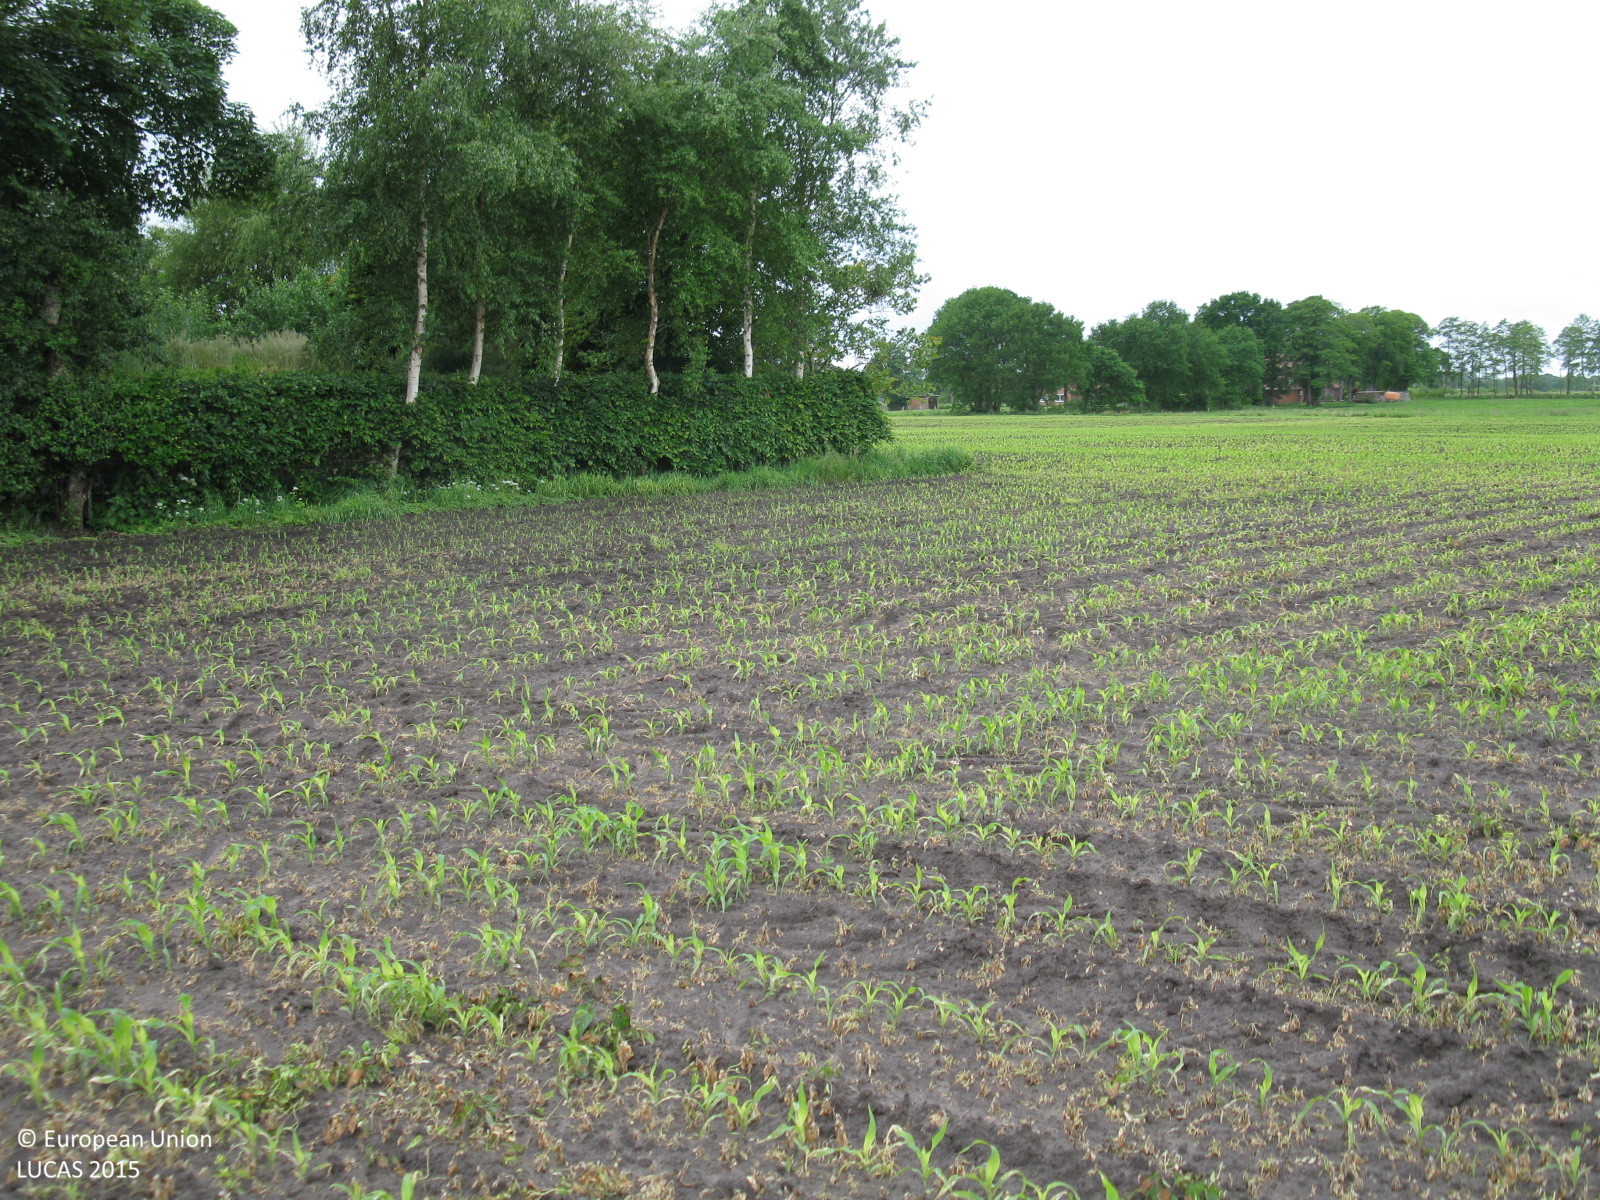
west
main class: Cropland
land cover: Maize
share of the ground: 10 - 25 %
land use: Agriculture (excluding fallow land and kitchen gardens)
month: June
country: DE
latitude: 53.4452
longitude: 7.3658
